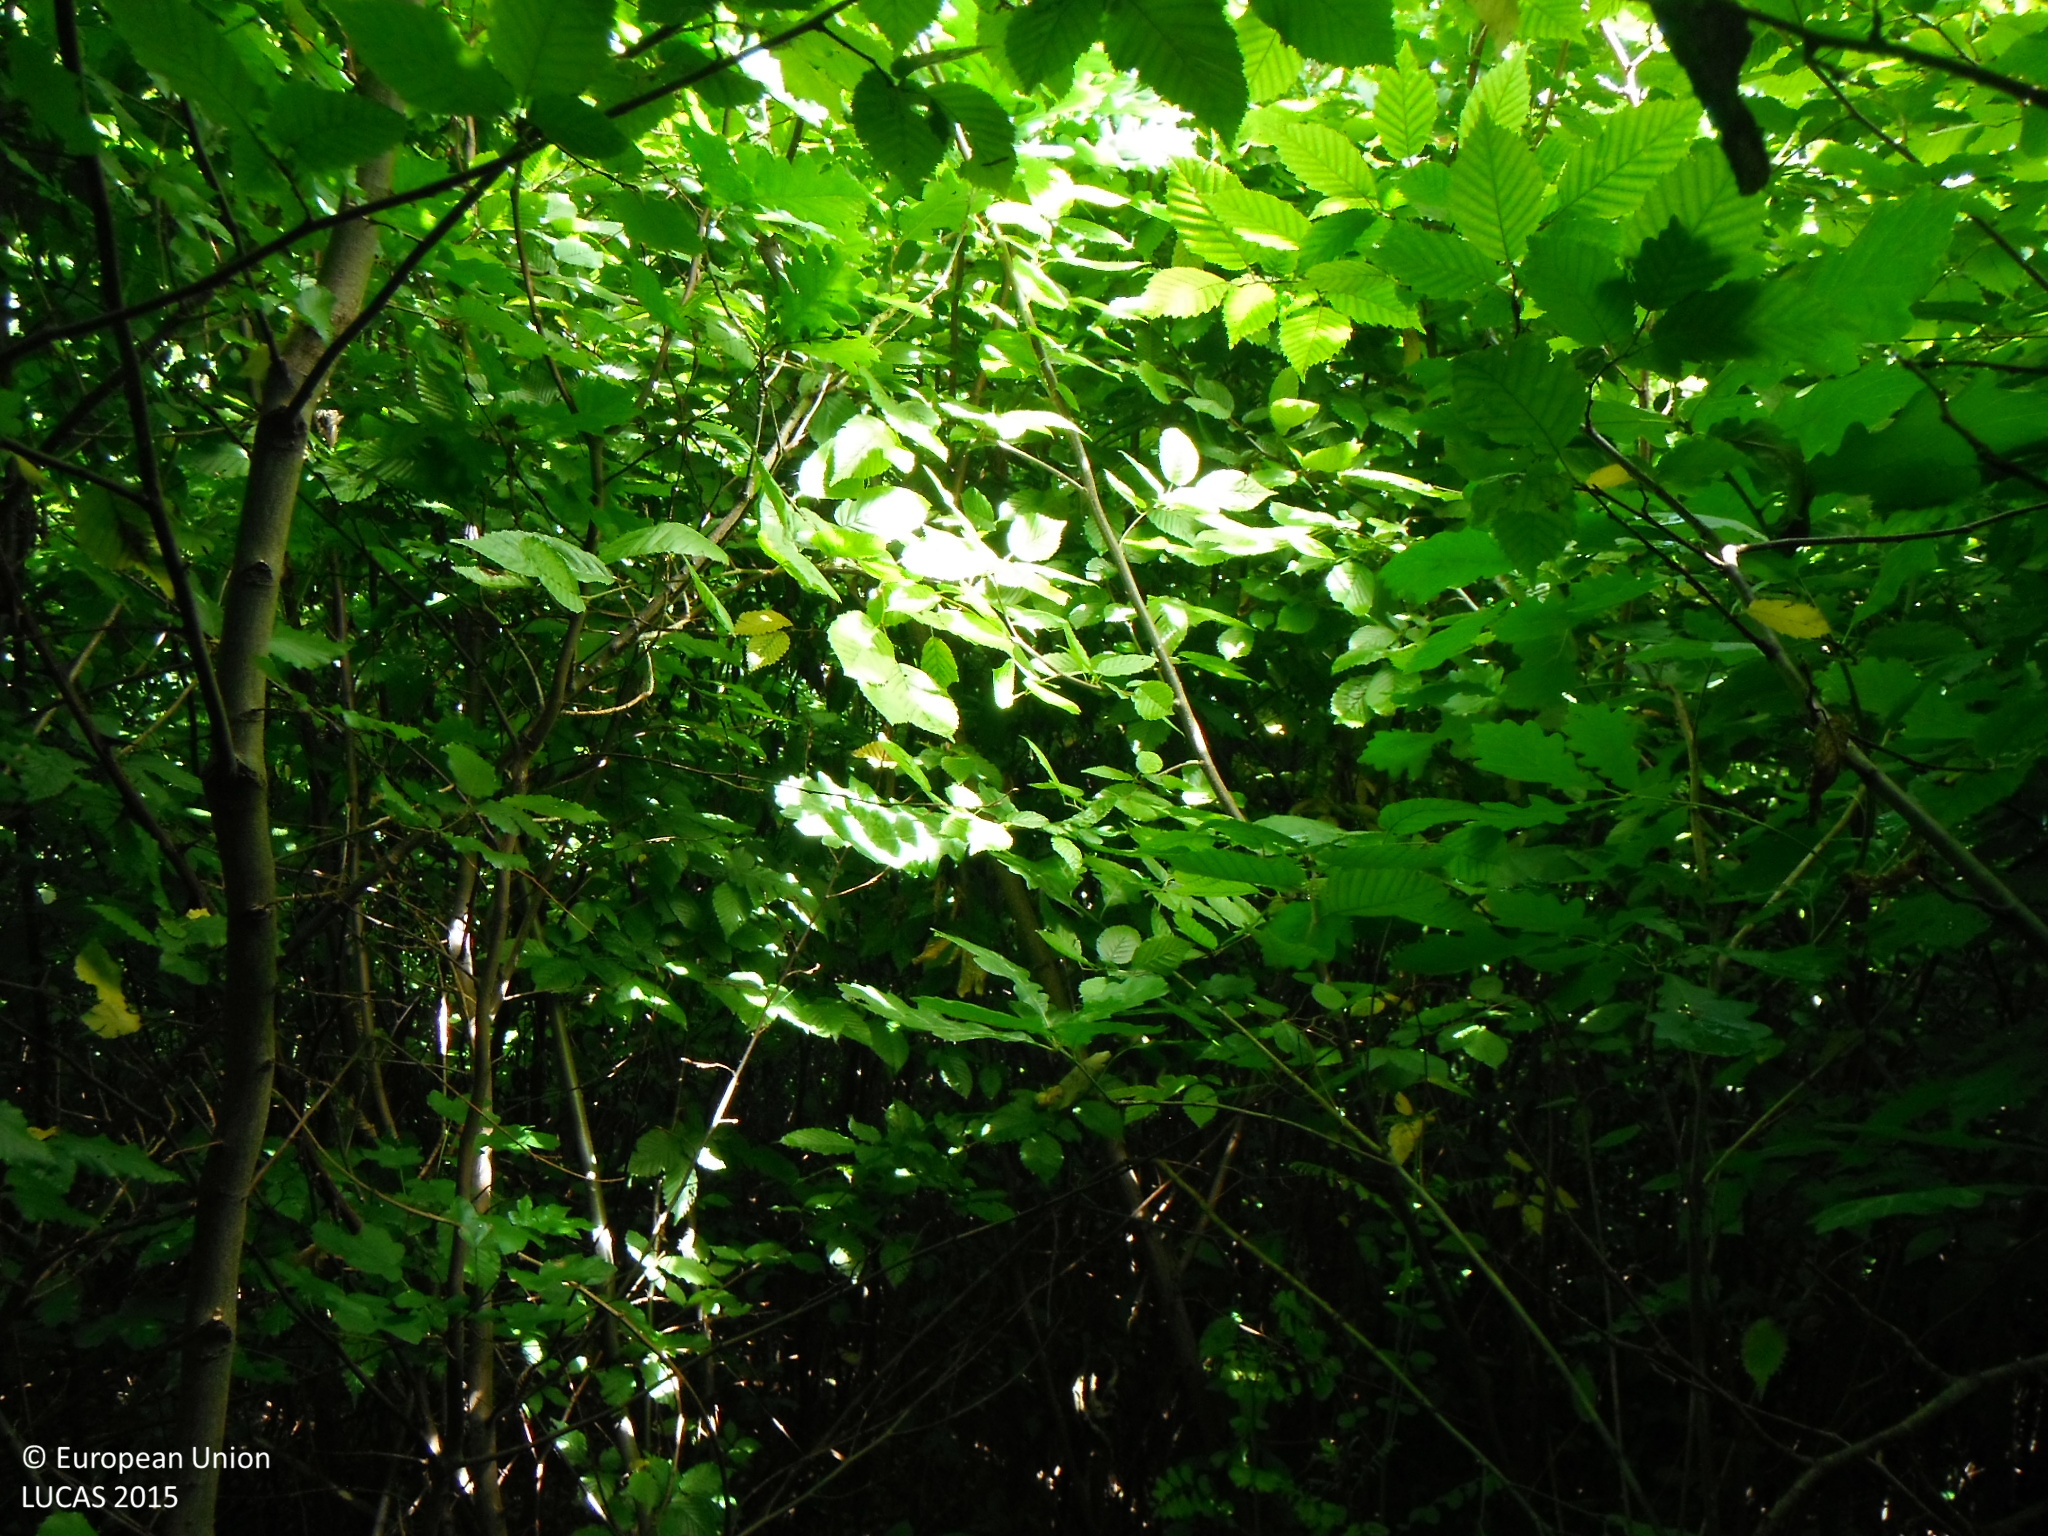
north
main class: Woodland
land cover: Broadleaved woodland
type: mesophytic deciduous forest
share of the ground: > 75 %
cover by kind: broadleaved forest trees 100 %
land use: Forestry
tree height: > 5 m
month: June
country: SK
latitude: 48.2123
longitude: 19.4847
